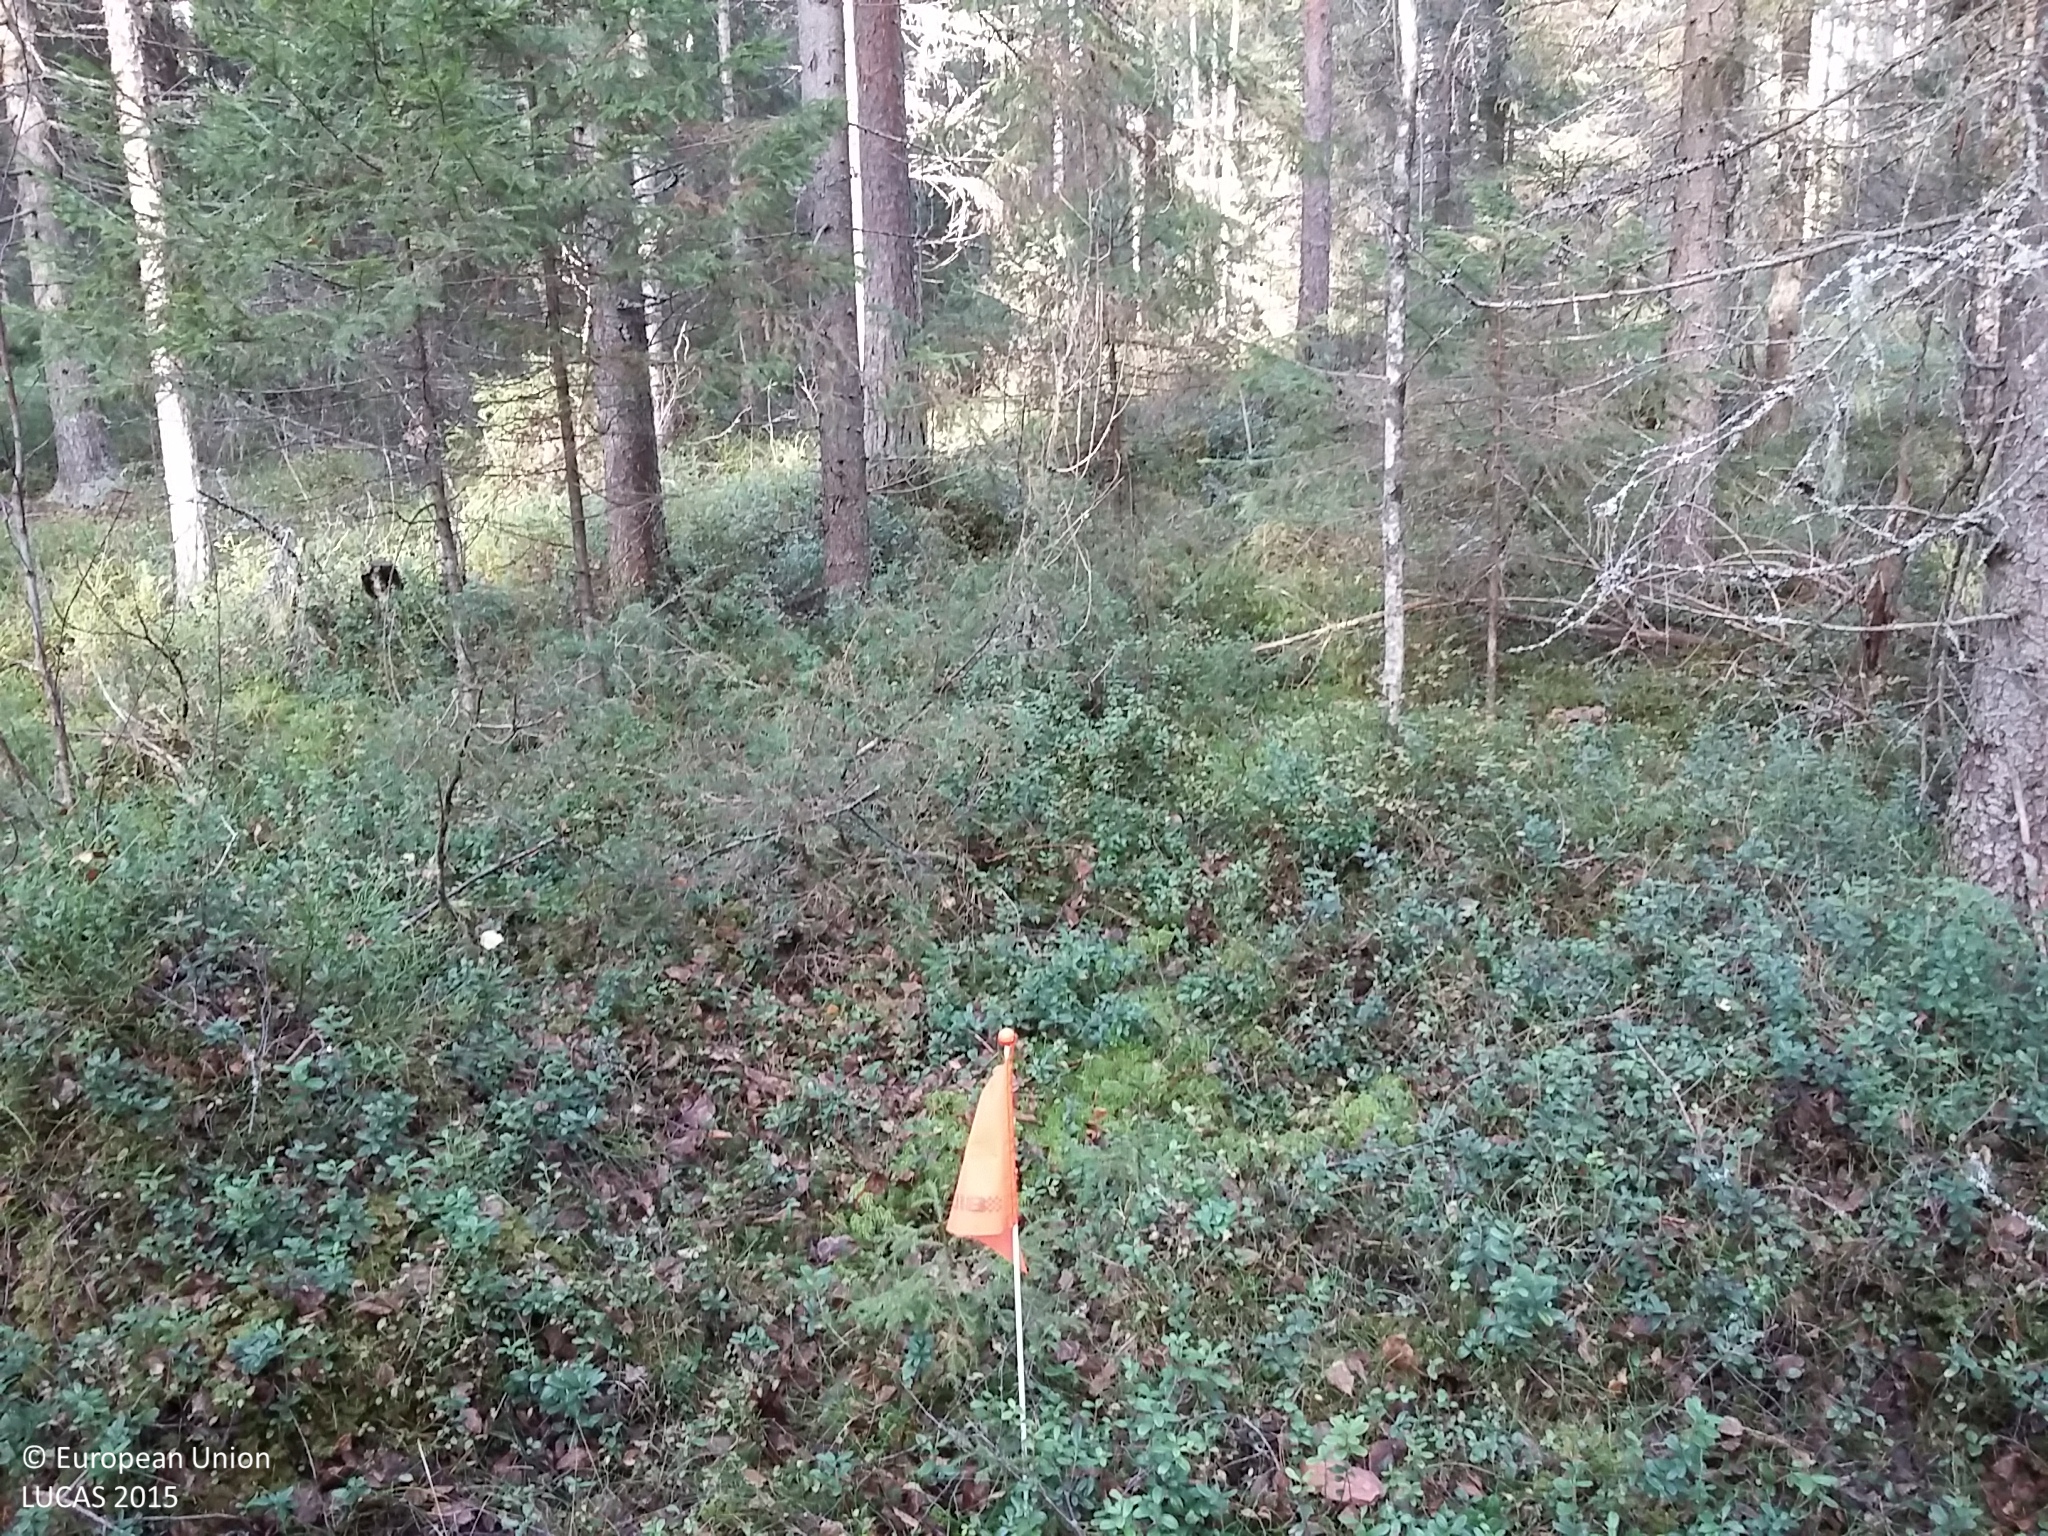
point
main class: Woodland
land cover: Spruce dominated coniferous woodland
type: boreal forest
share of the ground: > 75 %
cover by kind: coniferous forest trees 80 %, broadleaved forest trees 10 %, herbaceous plants 5 %, lichens and mosses 5 %
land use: Forestry
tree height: > 5 m
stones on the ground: < 10 %
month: October
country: FI
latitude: 63.9593
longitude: 24.9679
